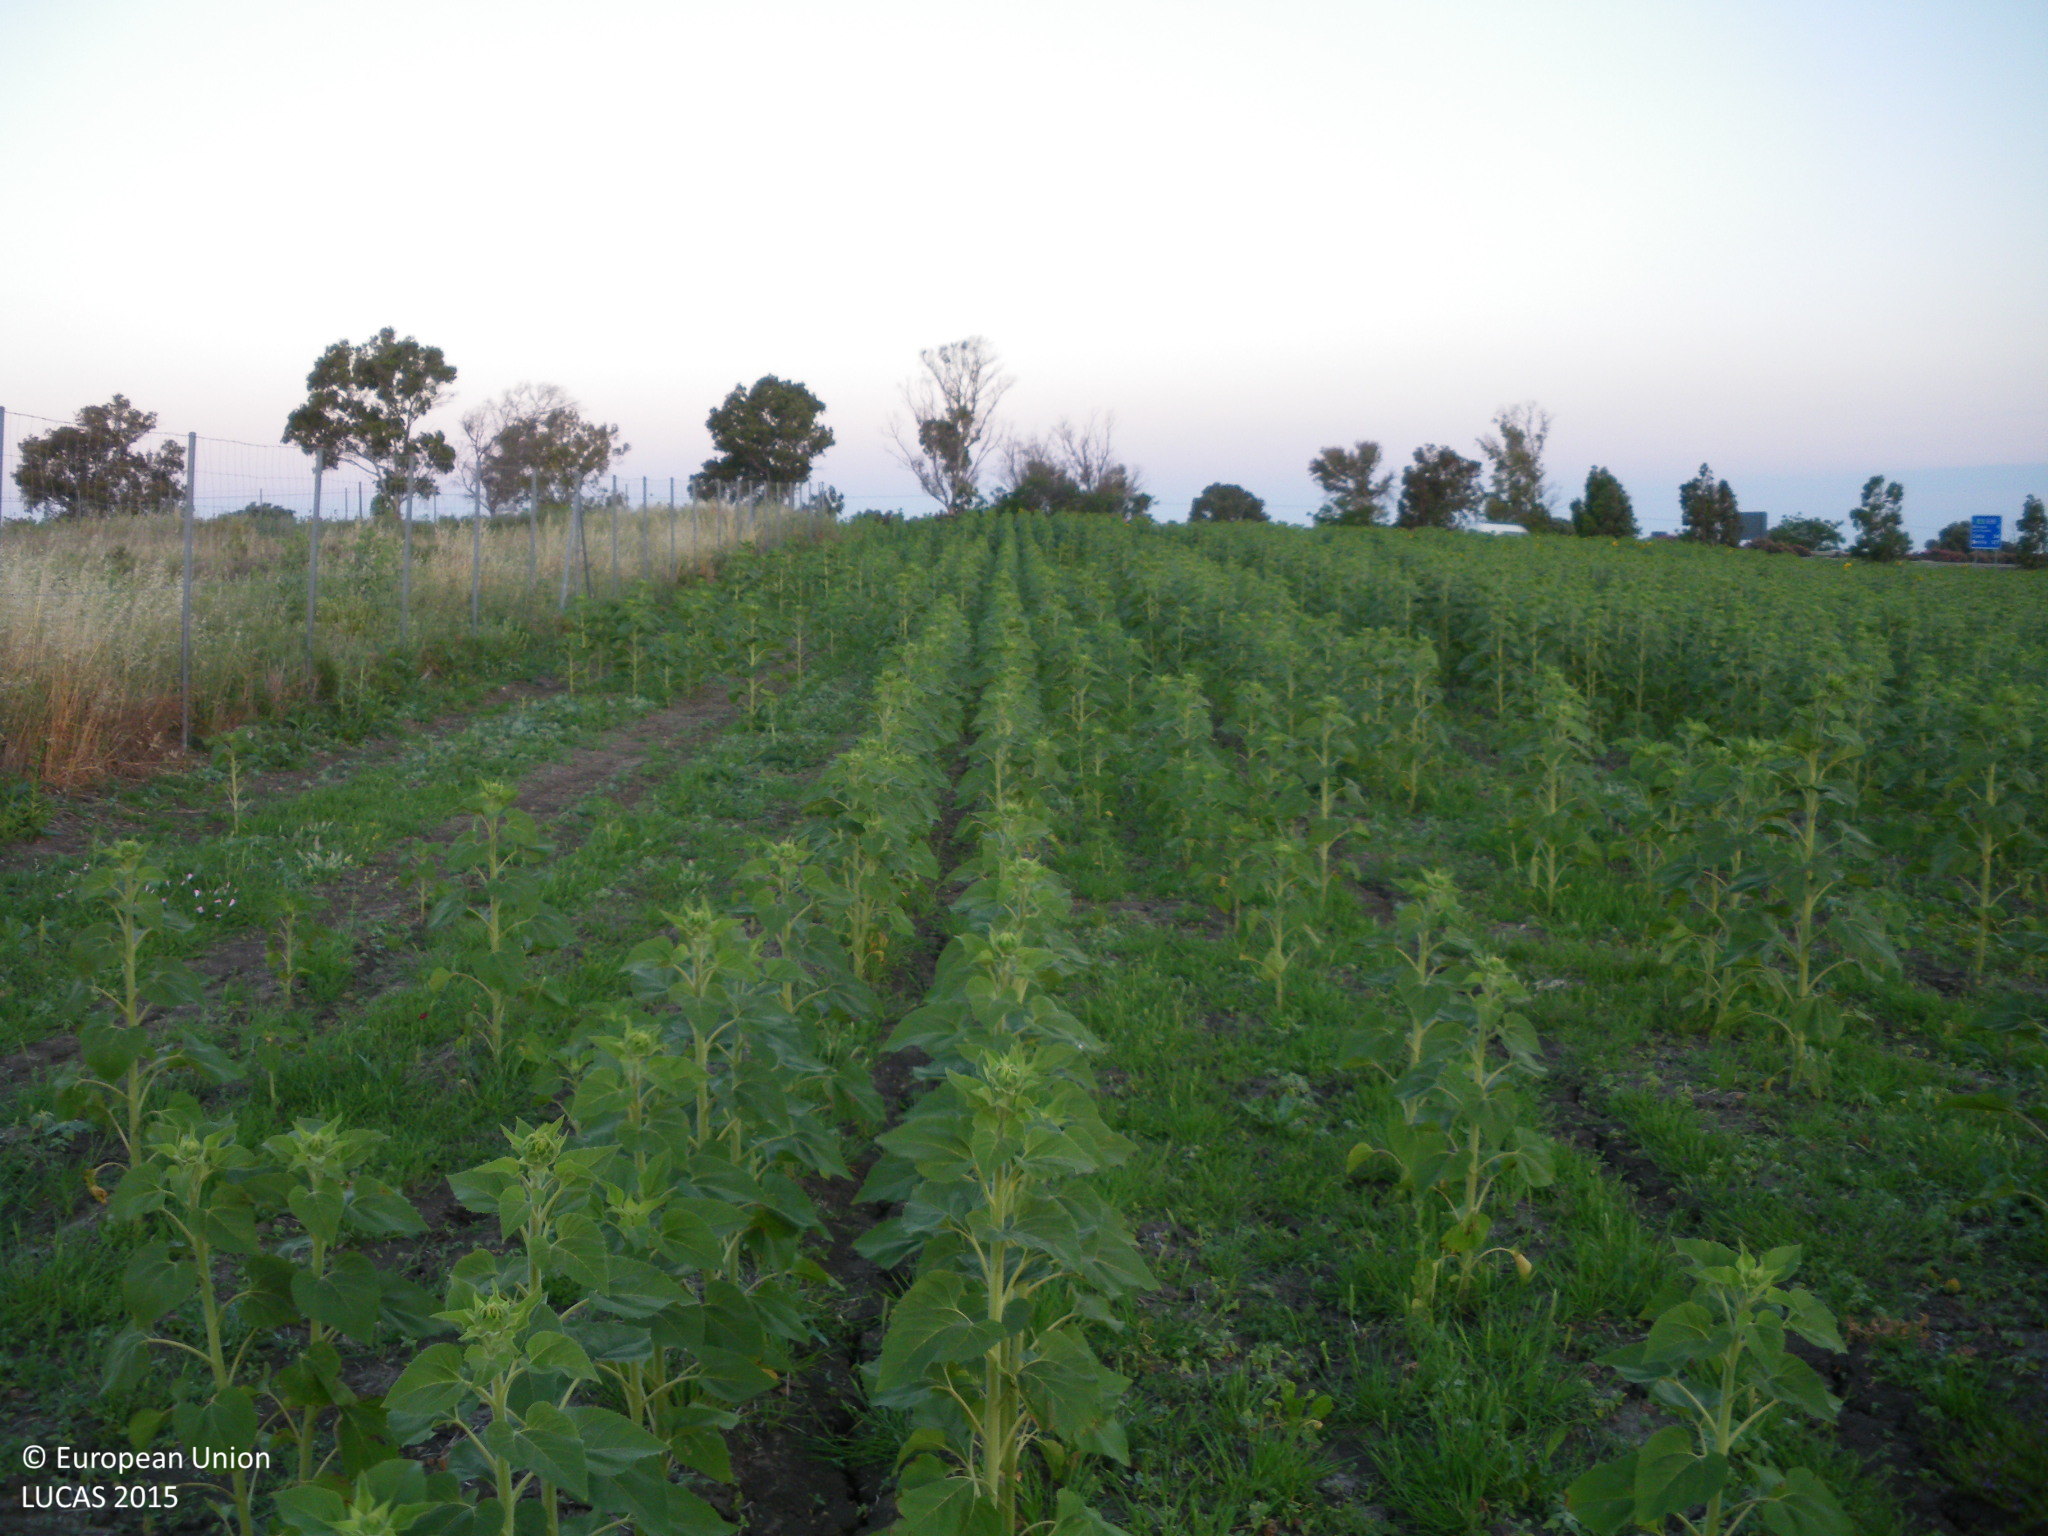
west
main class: Cropland
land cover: Sunflower
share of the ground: 25 - 50 %
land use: Agriculture (excluding fallow land and kitchen gardens)
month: May
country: ES
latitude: 36.3642
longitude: -6.1097
